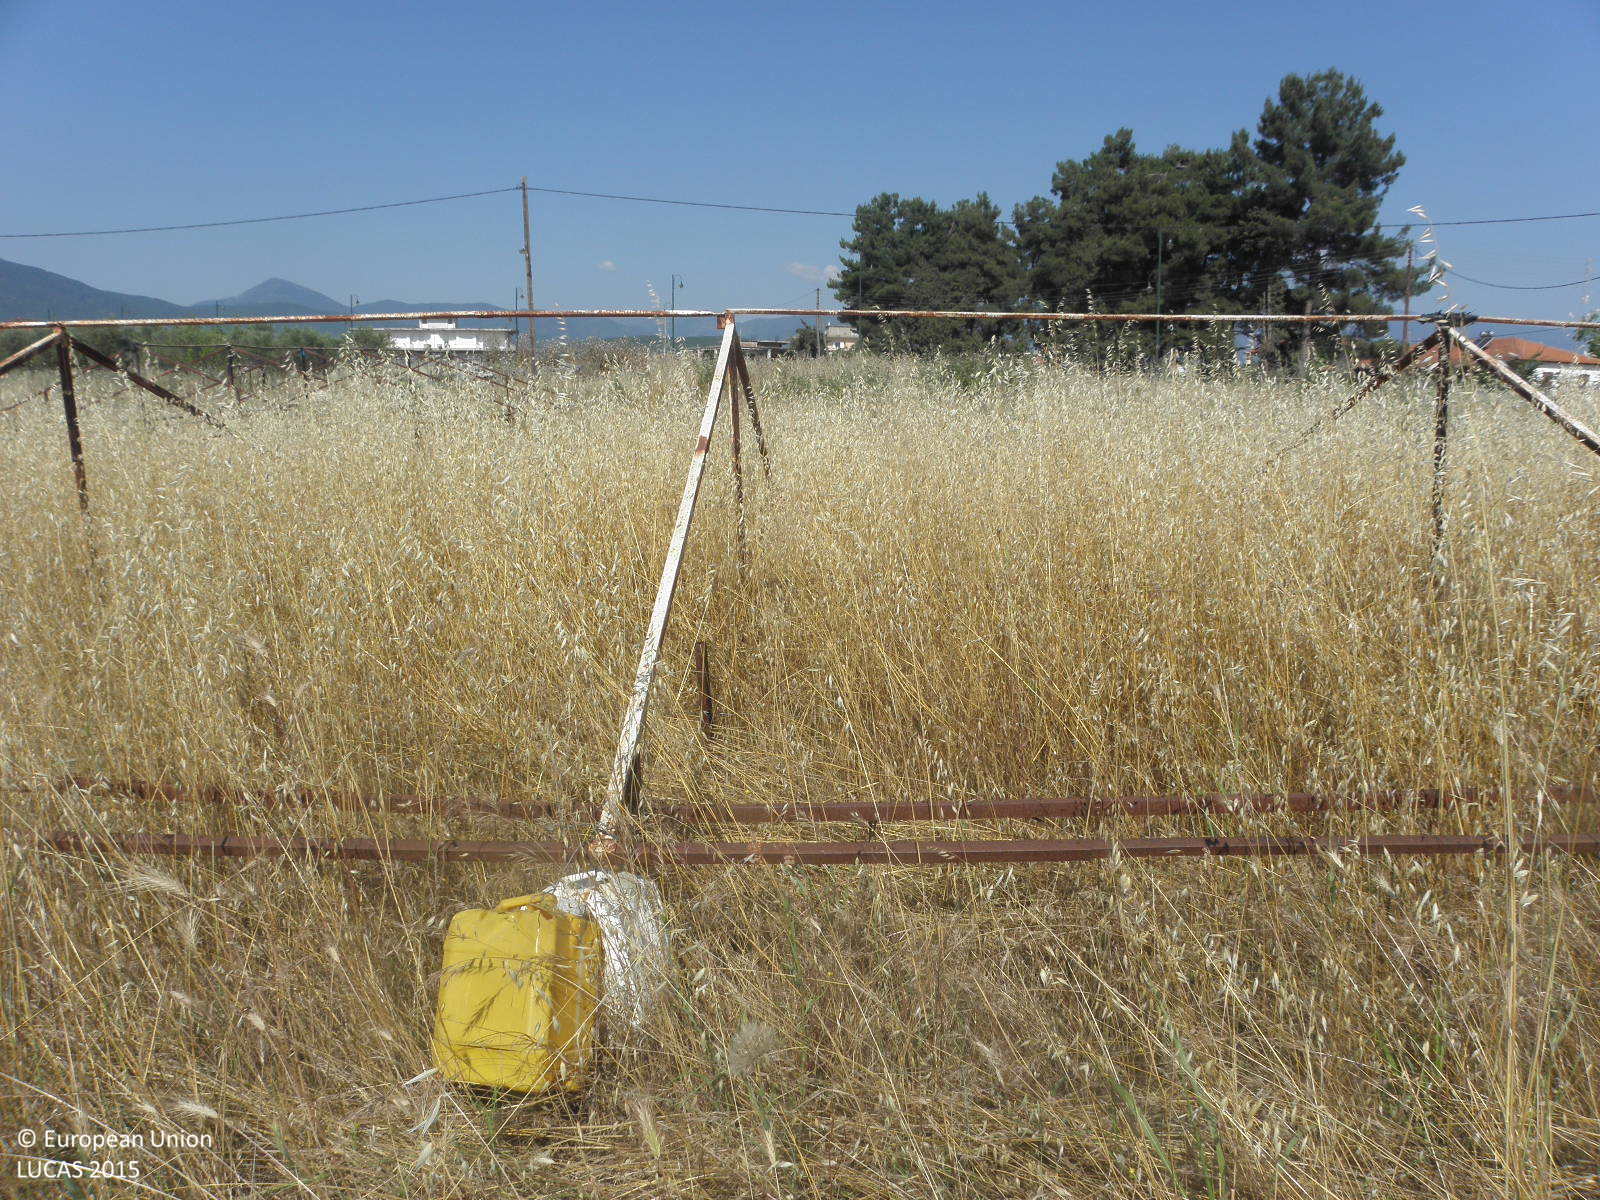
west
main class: Grassland
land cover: Spontaneously vegetated surfaces
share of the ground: > 75 %
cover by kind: herbaceous plants 100 %
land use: Fallow land
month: June
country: GR
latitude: 40.2038
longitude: 22.4381
